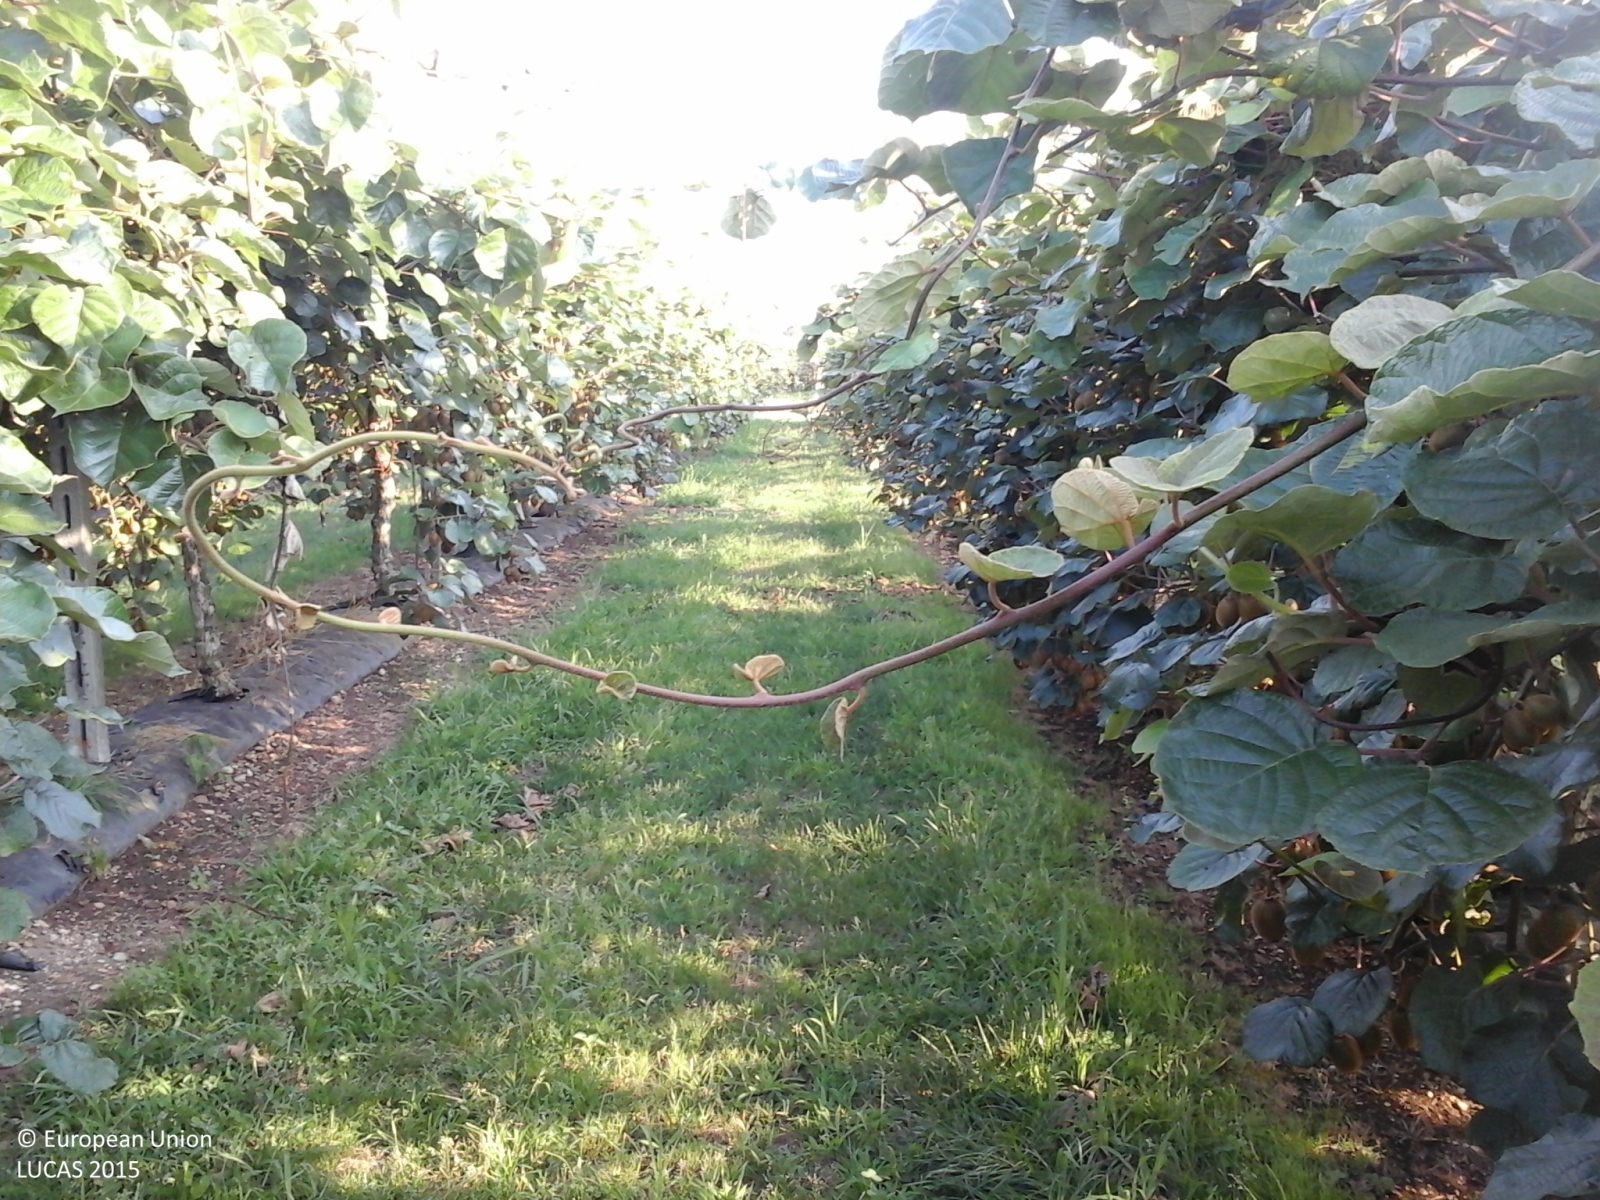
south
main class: Cropland
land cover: Other fruit trees and berries
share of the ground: > 75 %
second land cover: Grassland without tree/shrub cover
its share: > 75 %
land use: Agriculture (excluding fallow land and kitchen gardens)
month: July
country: IT
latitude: 45.3741
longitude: 10.9305
